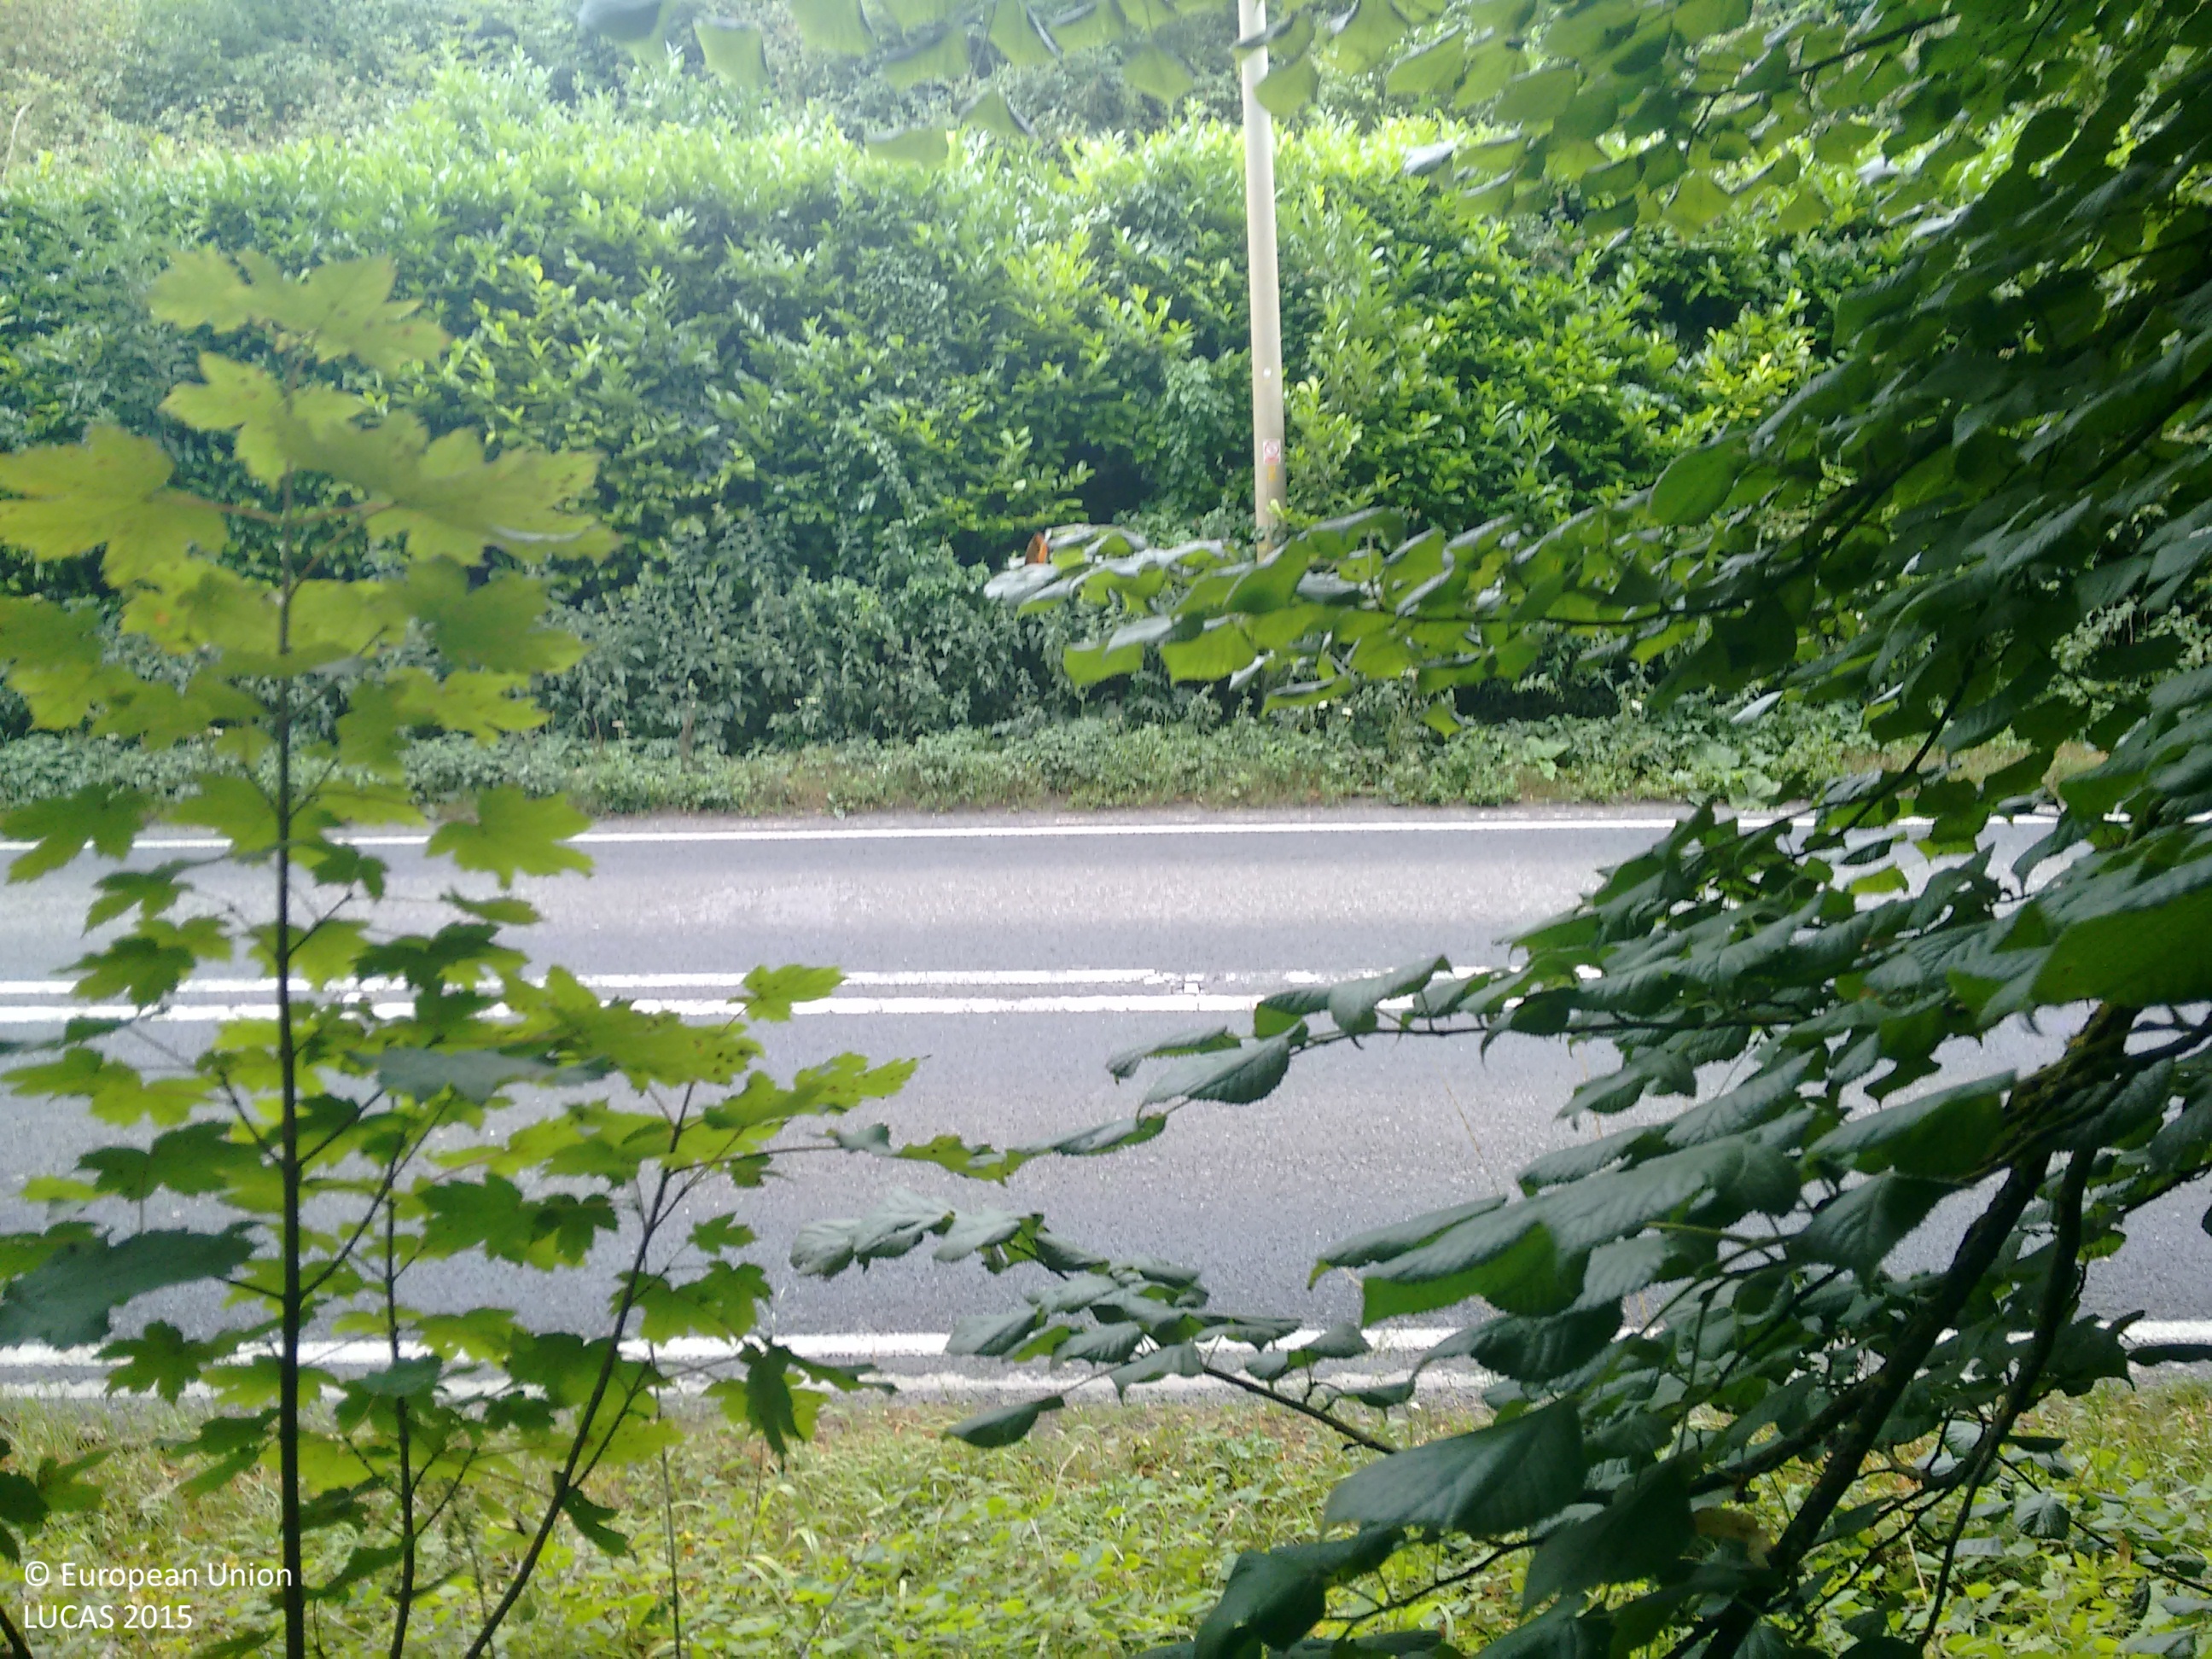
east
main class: Woodland
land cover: Broadleaved woodland
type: mesophytic deciduous forest
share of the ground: > 75 %
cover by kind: broadleaved forest trees 100 %
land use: Forestry
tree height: > 5 m
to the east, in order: Broadleaved woodland; Fences; Broadleaved woodland; Grass margins; Paved roads, cycling and walking lanes; Electric lines; Grass margins; Managed hedges; Broadleaved woodland; Grassland with sparse tree/shrub cover; Paved roads, cycling and walking lanes; Grassland with sparse tree/shrub cover; Paved roads, cycling and walking lanes; Grassland with sparse tree/shrub cover; Inland fresh water bodies; Fences; Broadleaved woodland; Fences; Paved roads, cycling and walking lanes; Broadleaved woodland; Artificial constructions in urban areas
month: July
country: GB
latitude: 51.0002
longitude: -1.1180
